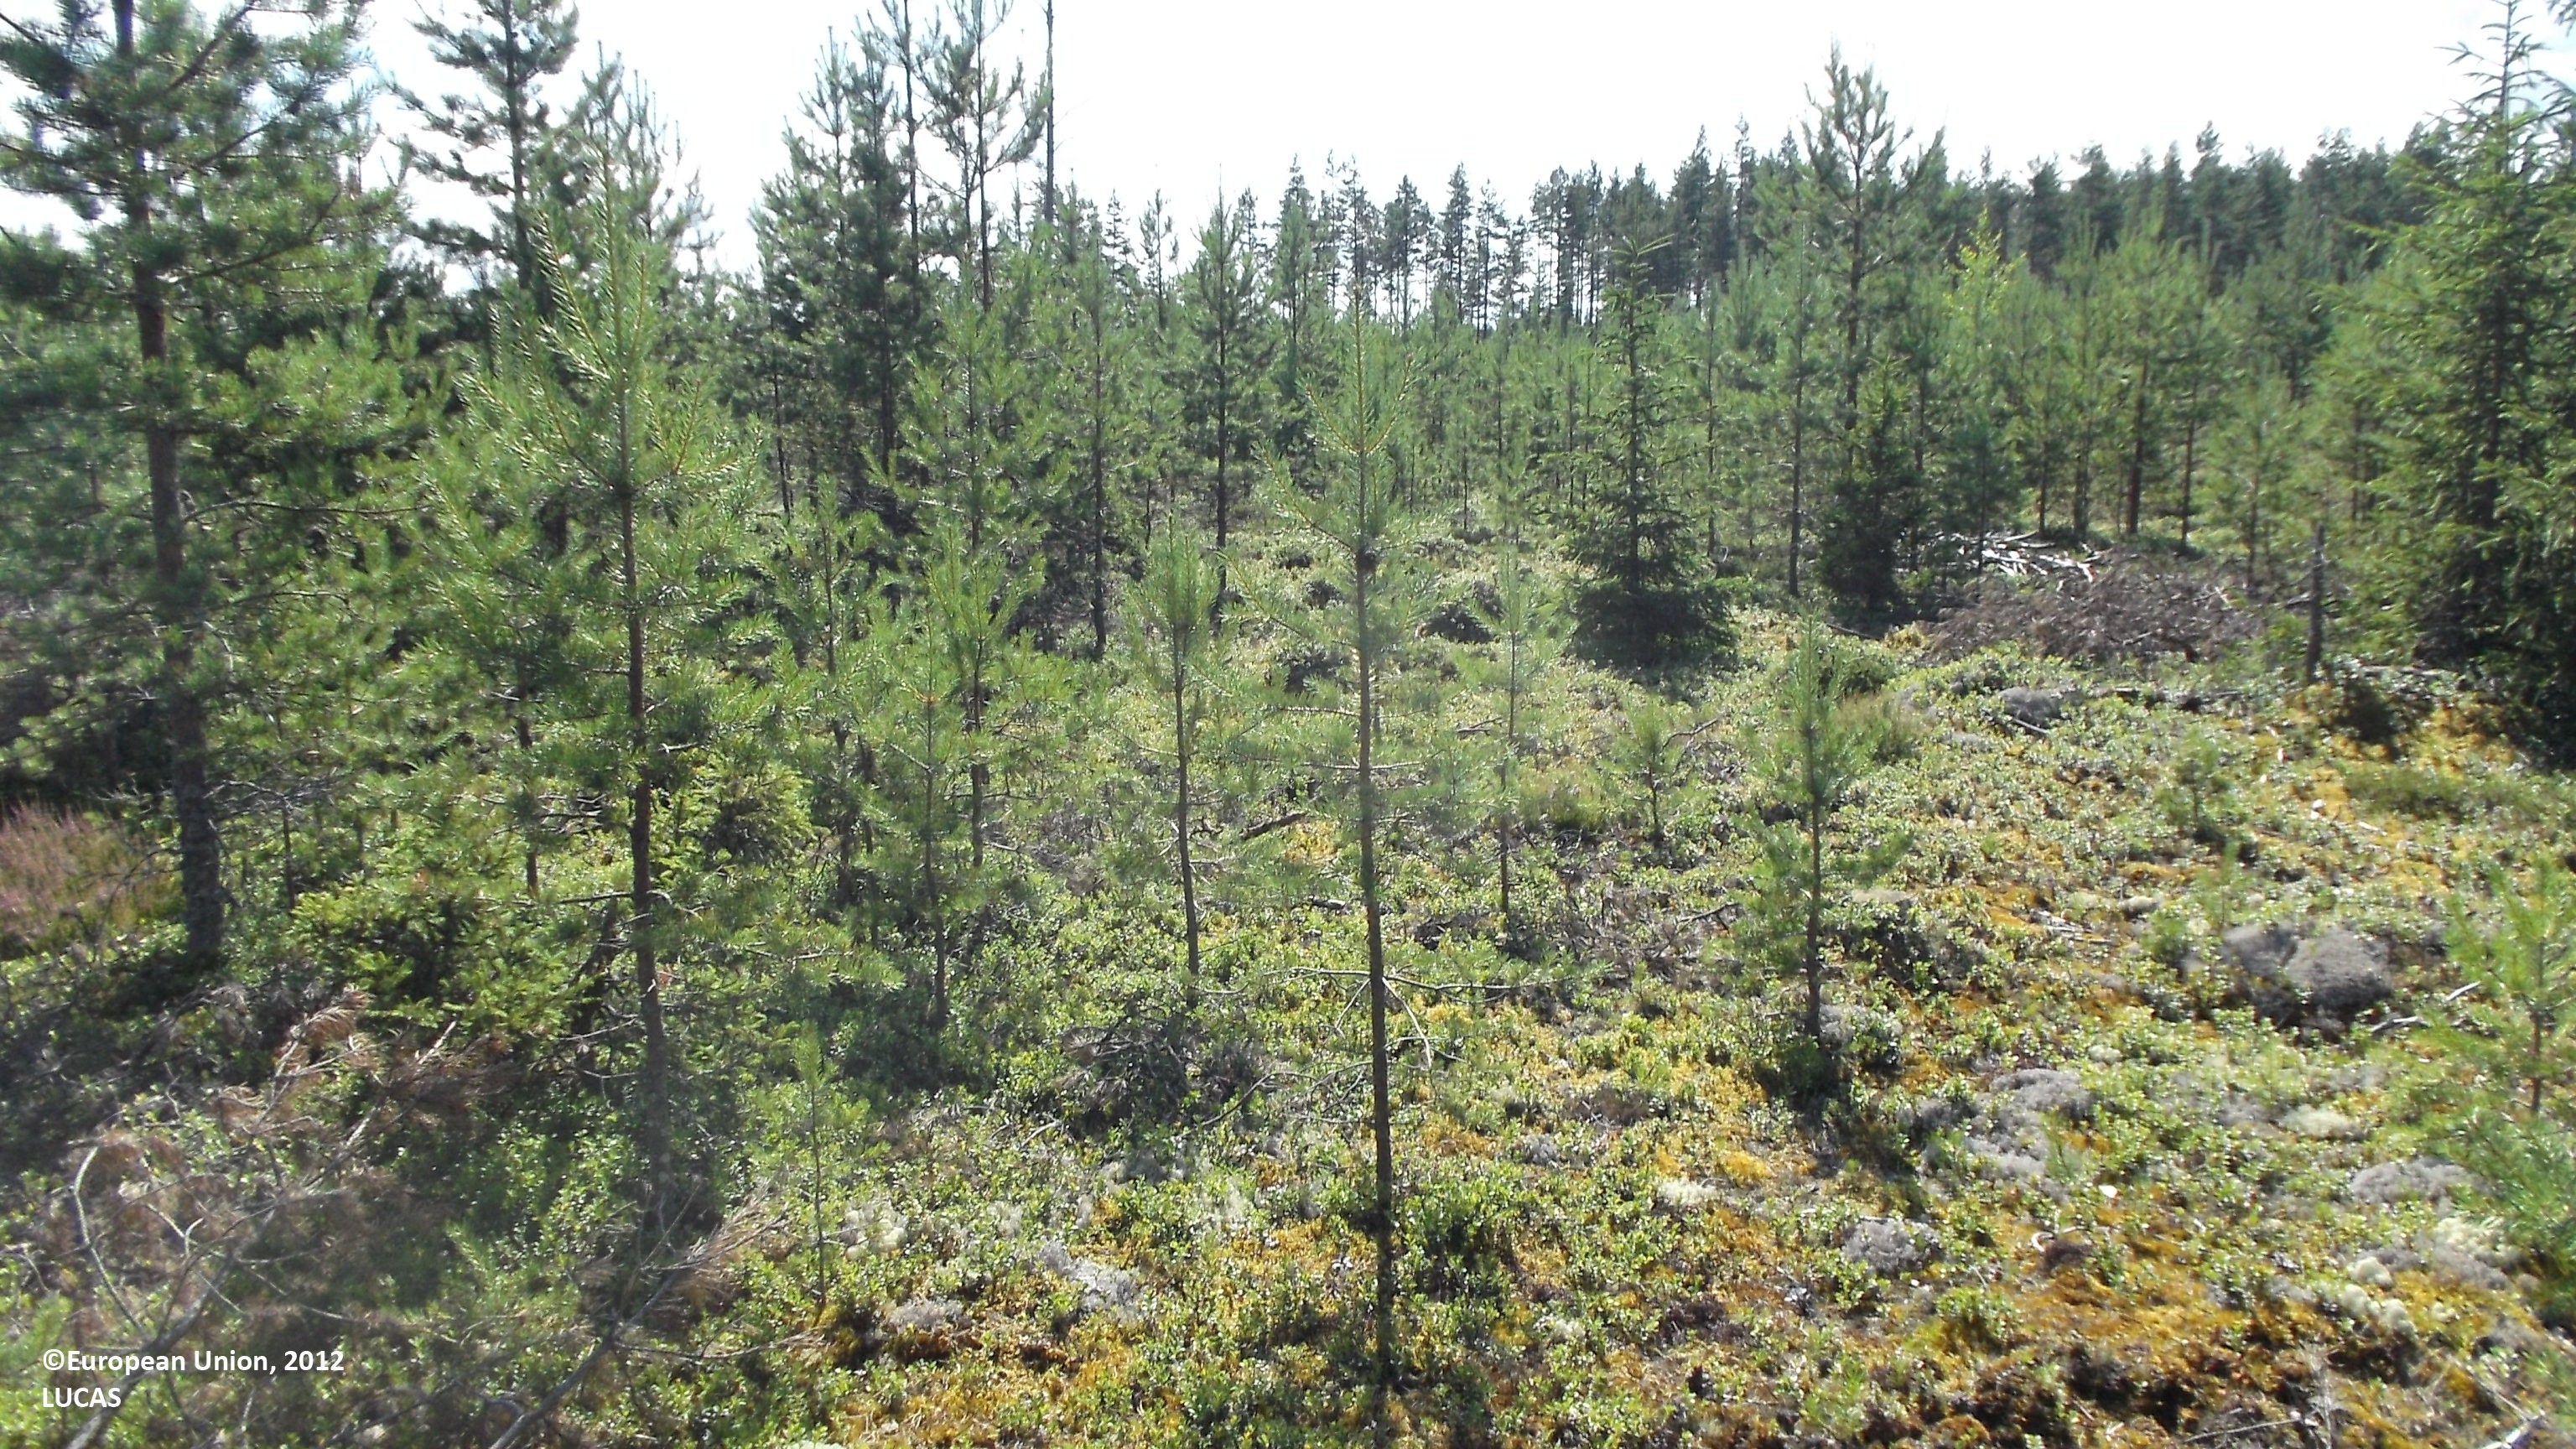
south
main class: Woodland
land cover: Pine dominated coniferous woodland
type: boreal forest
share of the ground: 25 - 50 %
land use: Forestry
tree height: < 5 m
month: July
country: FI
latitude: 63.8036
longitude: 23.0256
